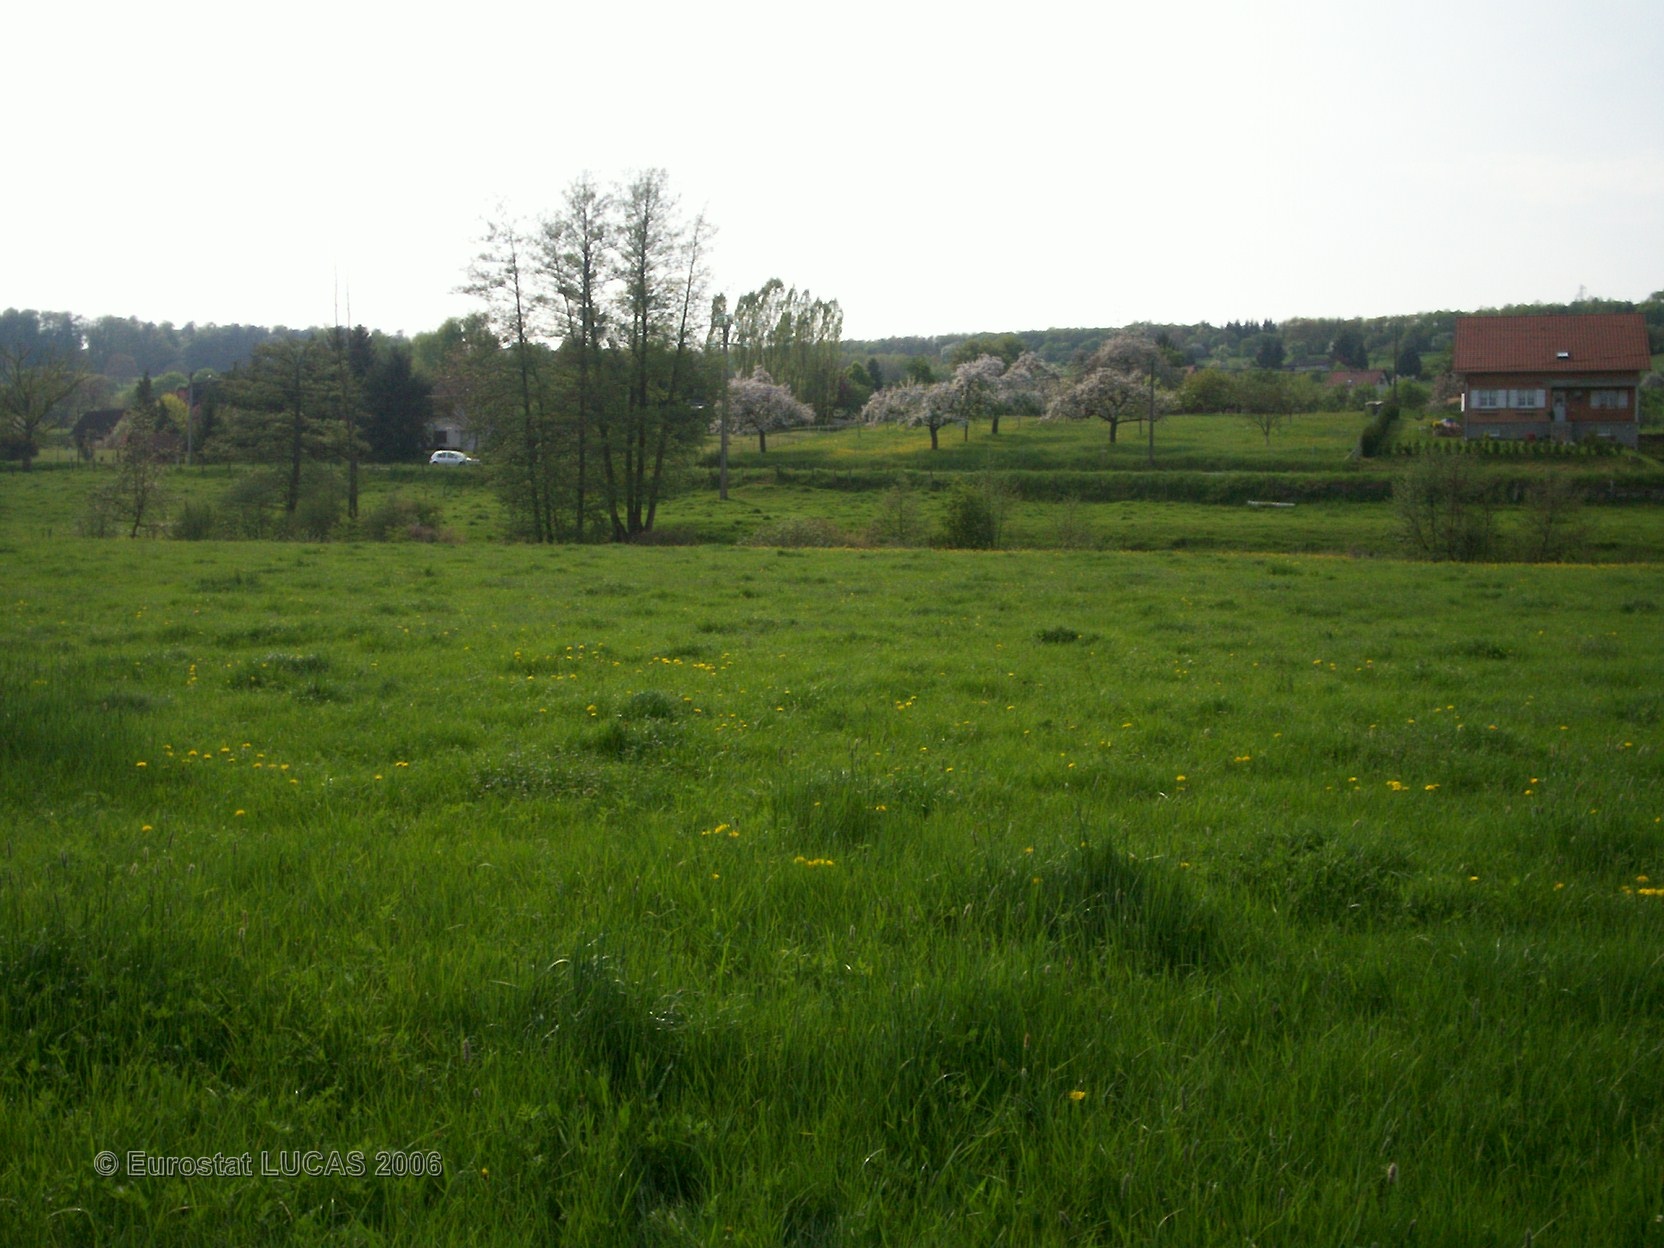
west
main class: Grassland
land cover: Grassland without tree/shrub cover
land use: Agriculture (excluding fallow land and kitchen gardens)
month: May
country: FR
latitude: 48.9047
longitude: 7.0673
